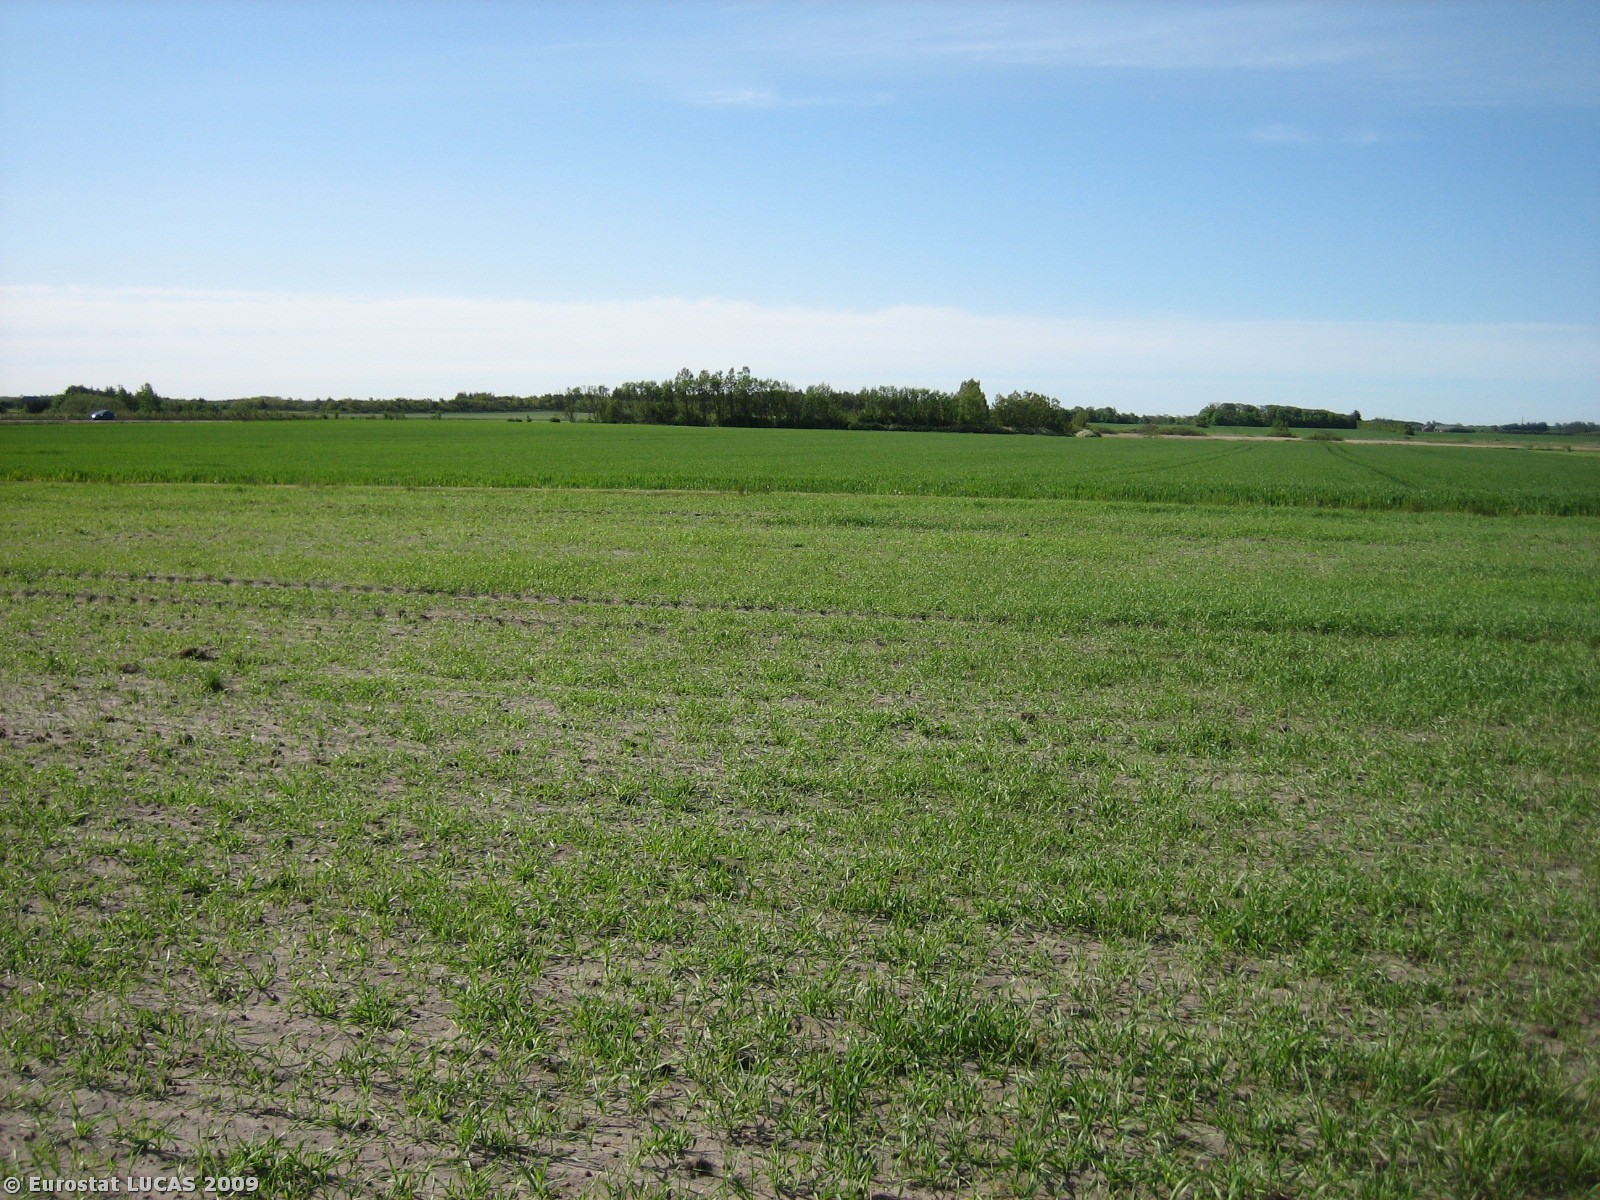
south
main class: Cropland
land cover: Barley
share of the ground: 50 - 75 %
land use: Agriculture (excluding fallow land and kitchen gardens)
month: May
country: DK
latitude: 56.1403
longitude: 8.2799
